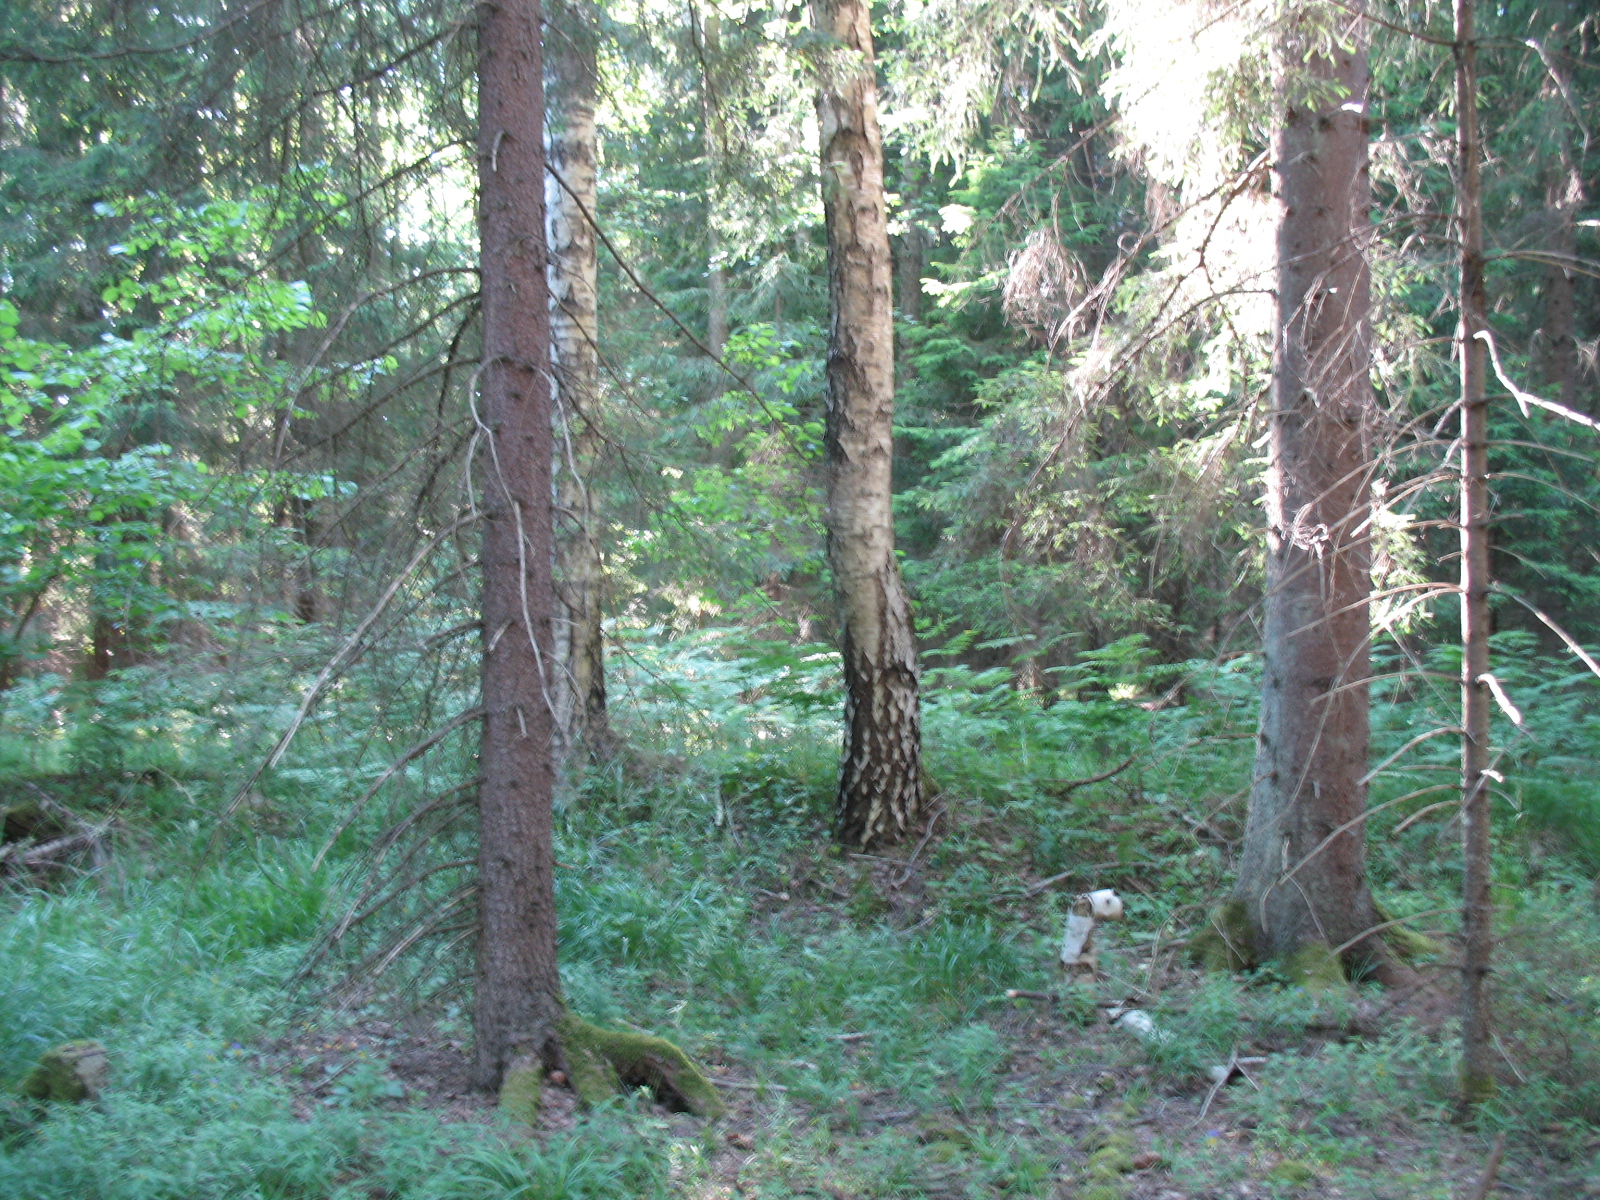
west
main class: Woodland
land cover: Spruce dominated mixed woodland
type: hemiboreal forest and nemoral coniferous forest and mixed broadleaved-coniferous forest
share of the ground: > 75 %
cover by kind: coniferous forest trees 45 %, broadleaved forest trees 45 %, herbaceous plants 5 %, lichens and mosses 5 %
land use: Forestry
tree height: > 5 m
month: July
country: LV
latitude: 56.7706
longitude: 23.8077
